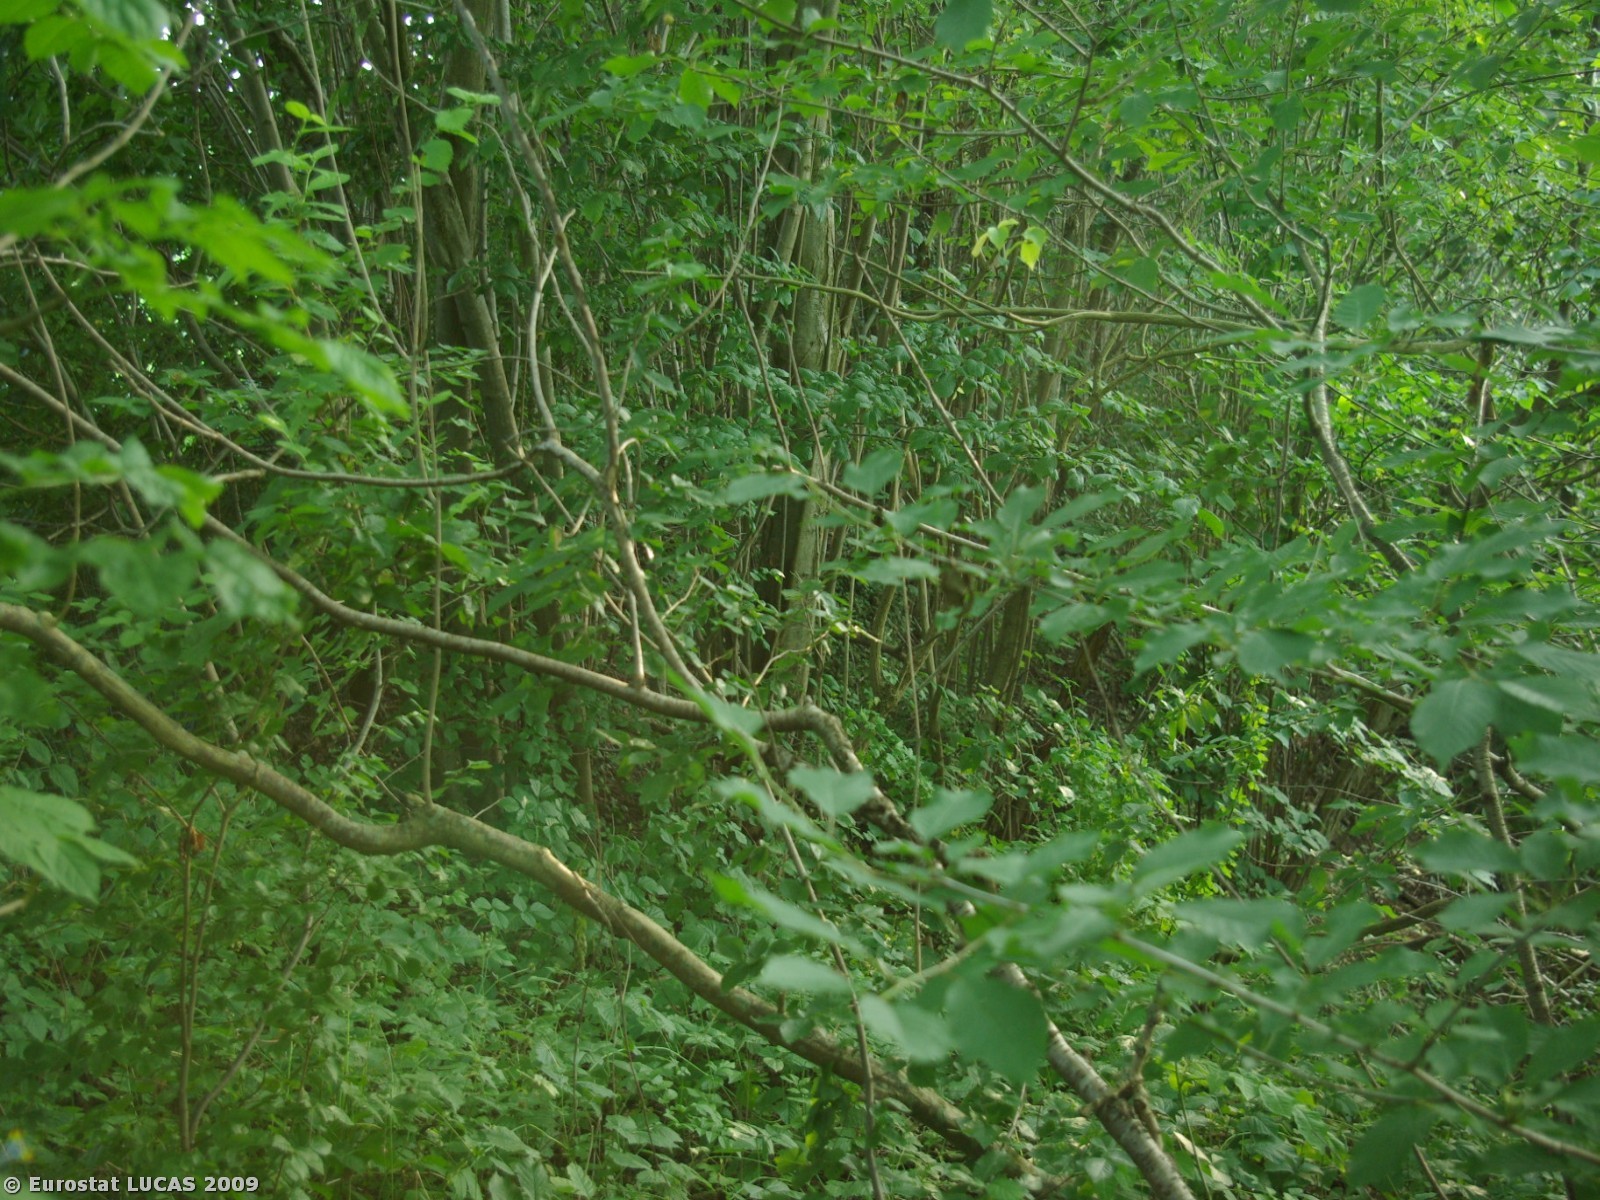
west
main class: Woodland
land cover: Broadleaved woodland
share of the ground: > 75 %
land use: Unused
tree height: > 5 m
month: July
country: DK
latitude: 54.9475
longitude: 9.8908
